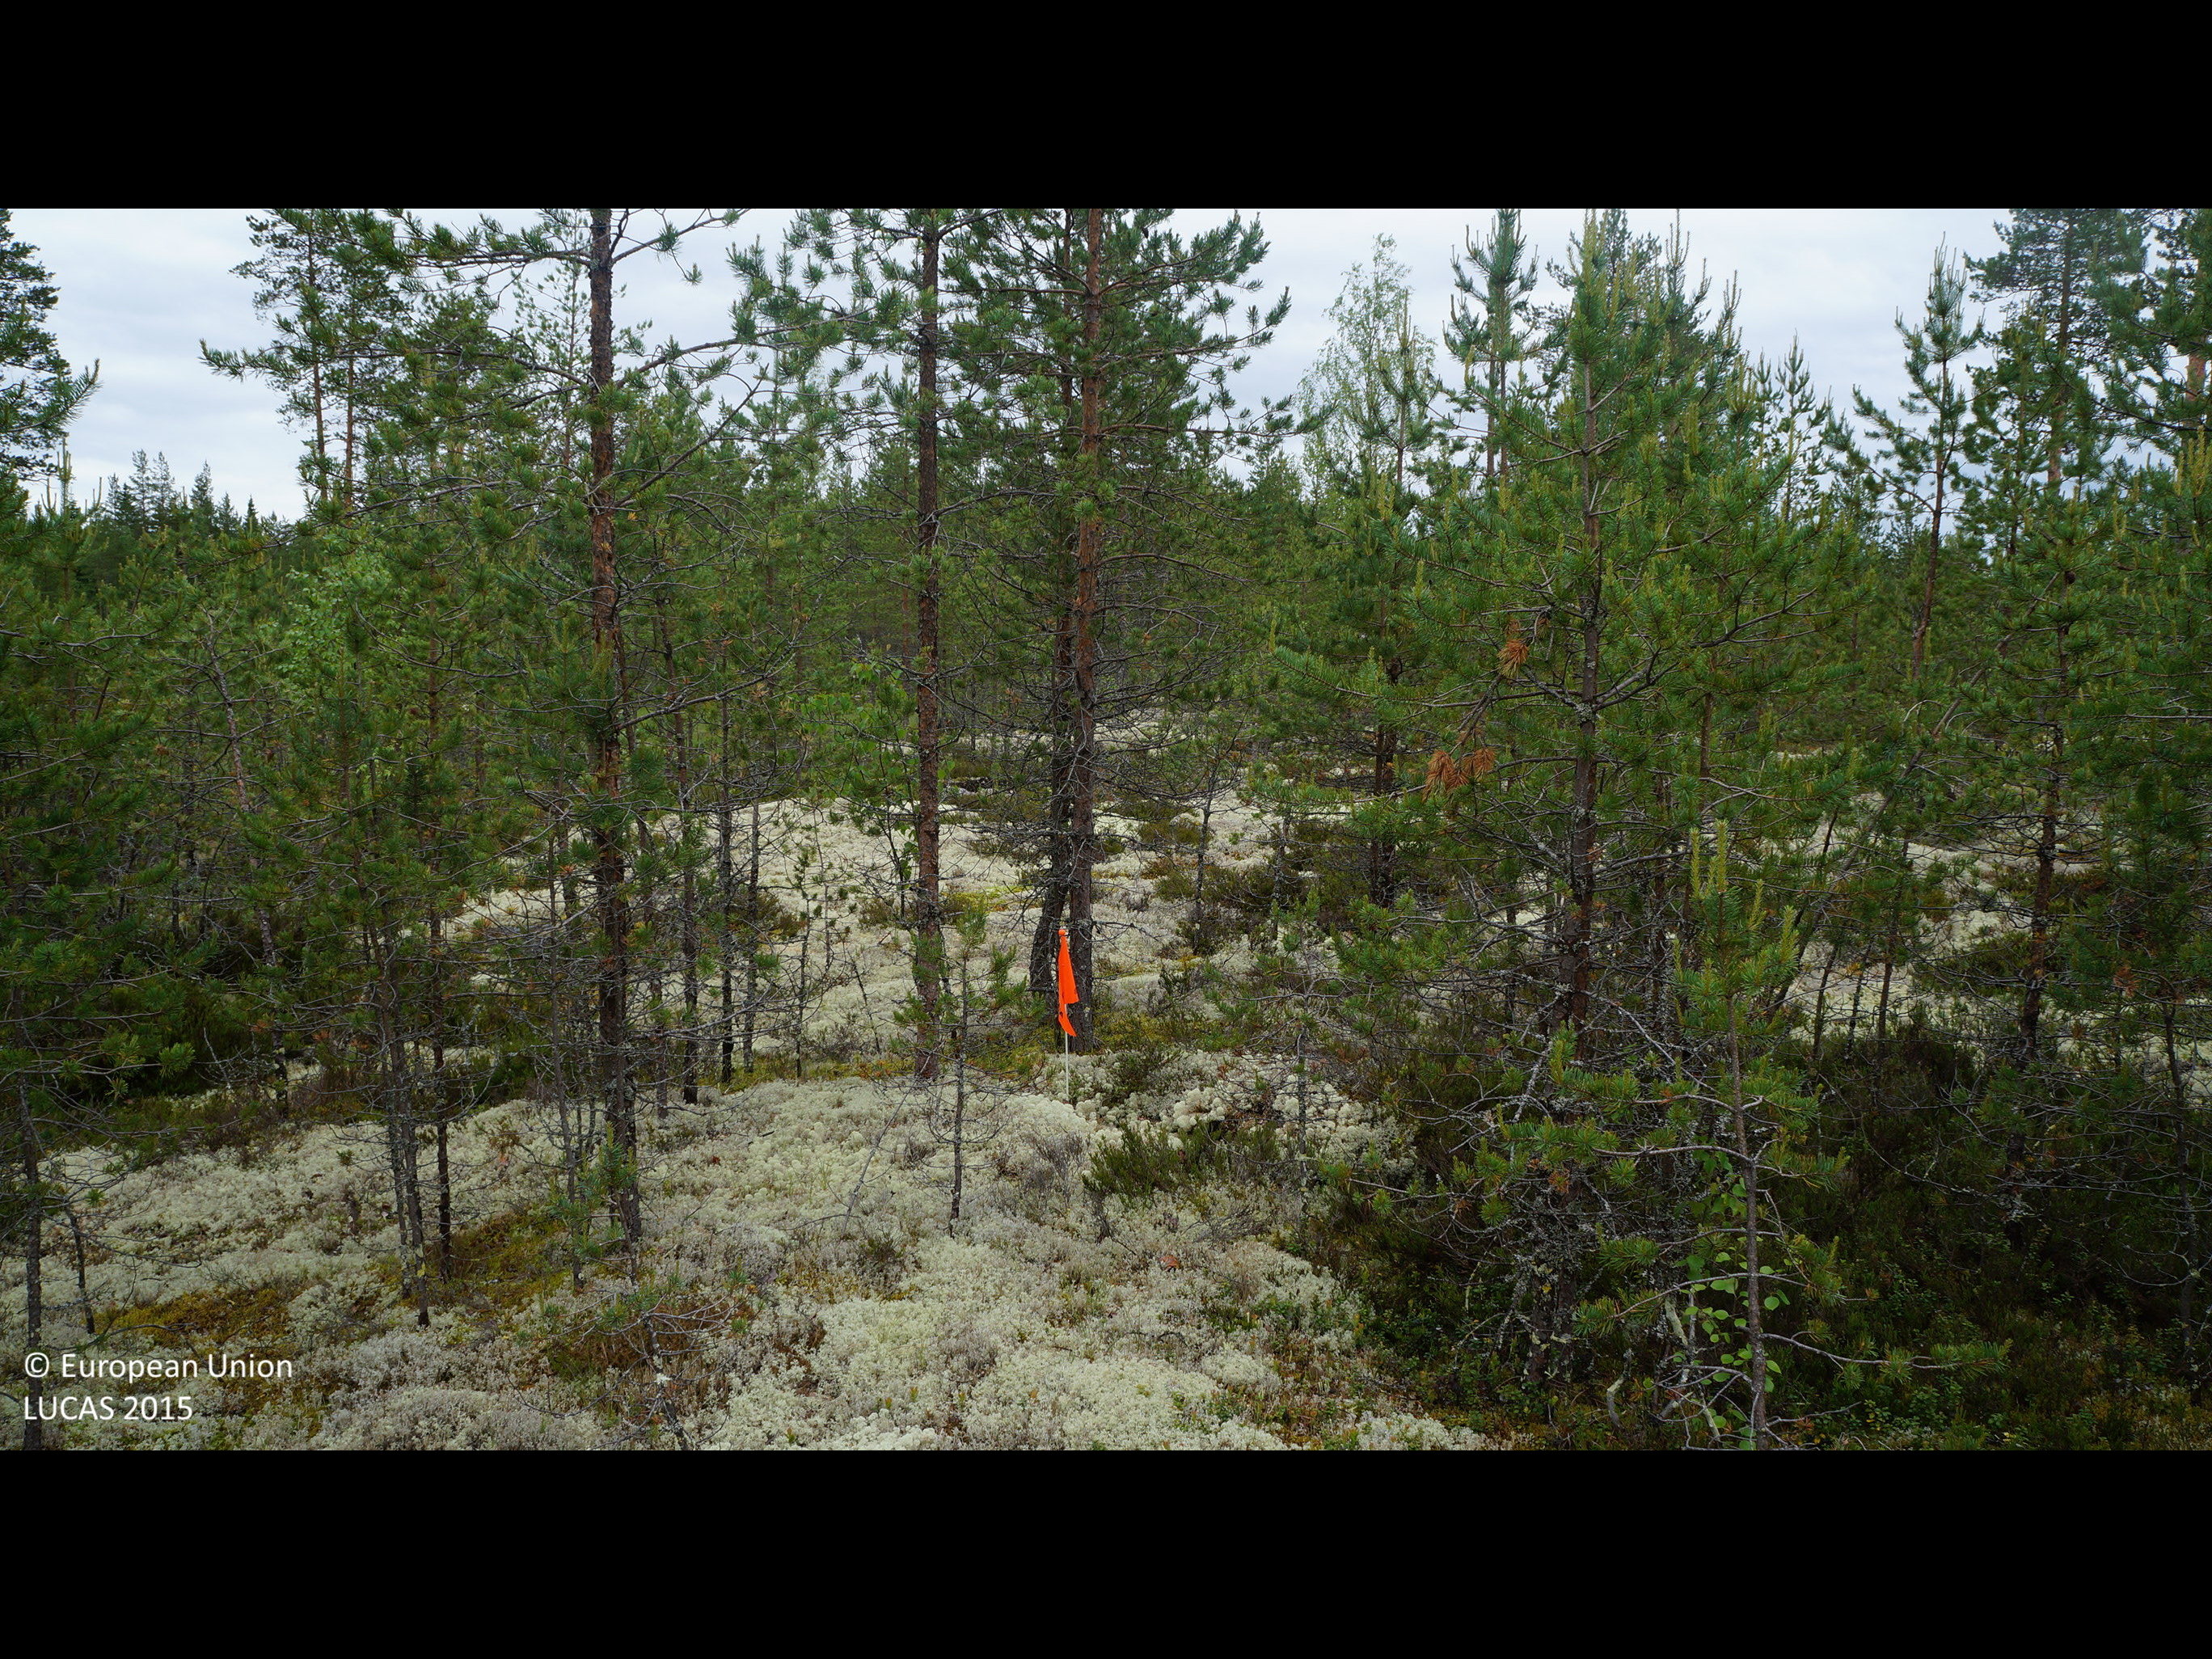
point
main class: Woodland
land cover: Pine dominated coniferous woodland
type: boreal forest
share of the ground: 25 - 50 %
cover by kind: coniferous forest trees 40 %, shrubs 30 %, lichens and mosses 25 %, broadleaved forest trees 5 %
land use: Forestry
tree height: > 5 m
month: June
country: FI
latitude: 64.3387
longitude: 24.6653
